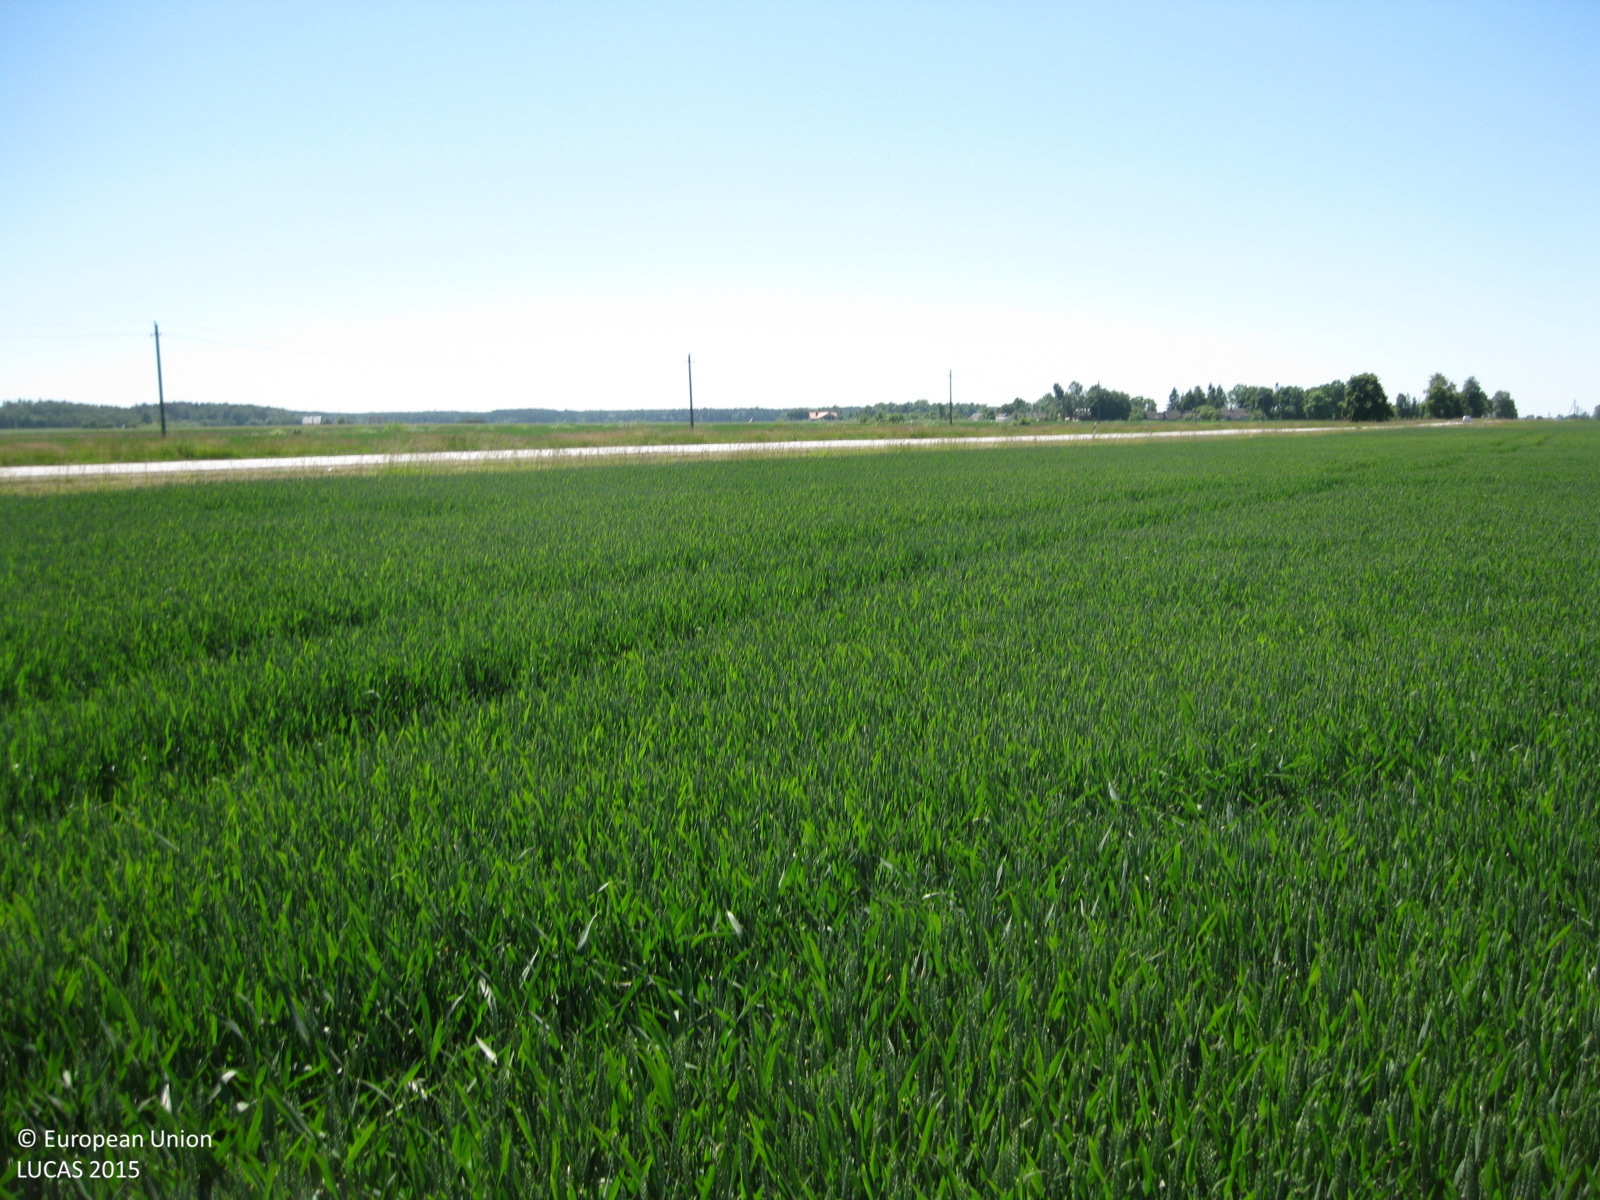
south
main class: Cropland
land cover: Common wheat
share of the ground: > 75 %
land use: Agriculture (excluding fallow land and kitchen gardens)
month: June
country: LT
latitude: 55.6779
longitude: 24.2633
